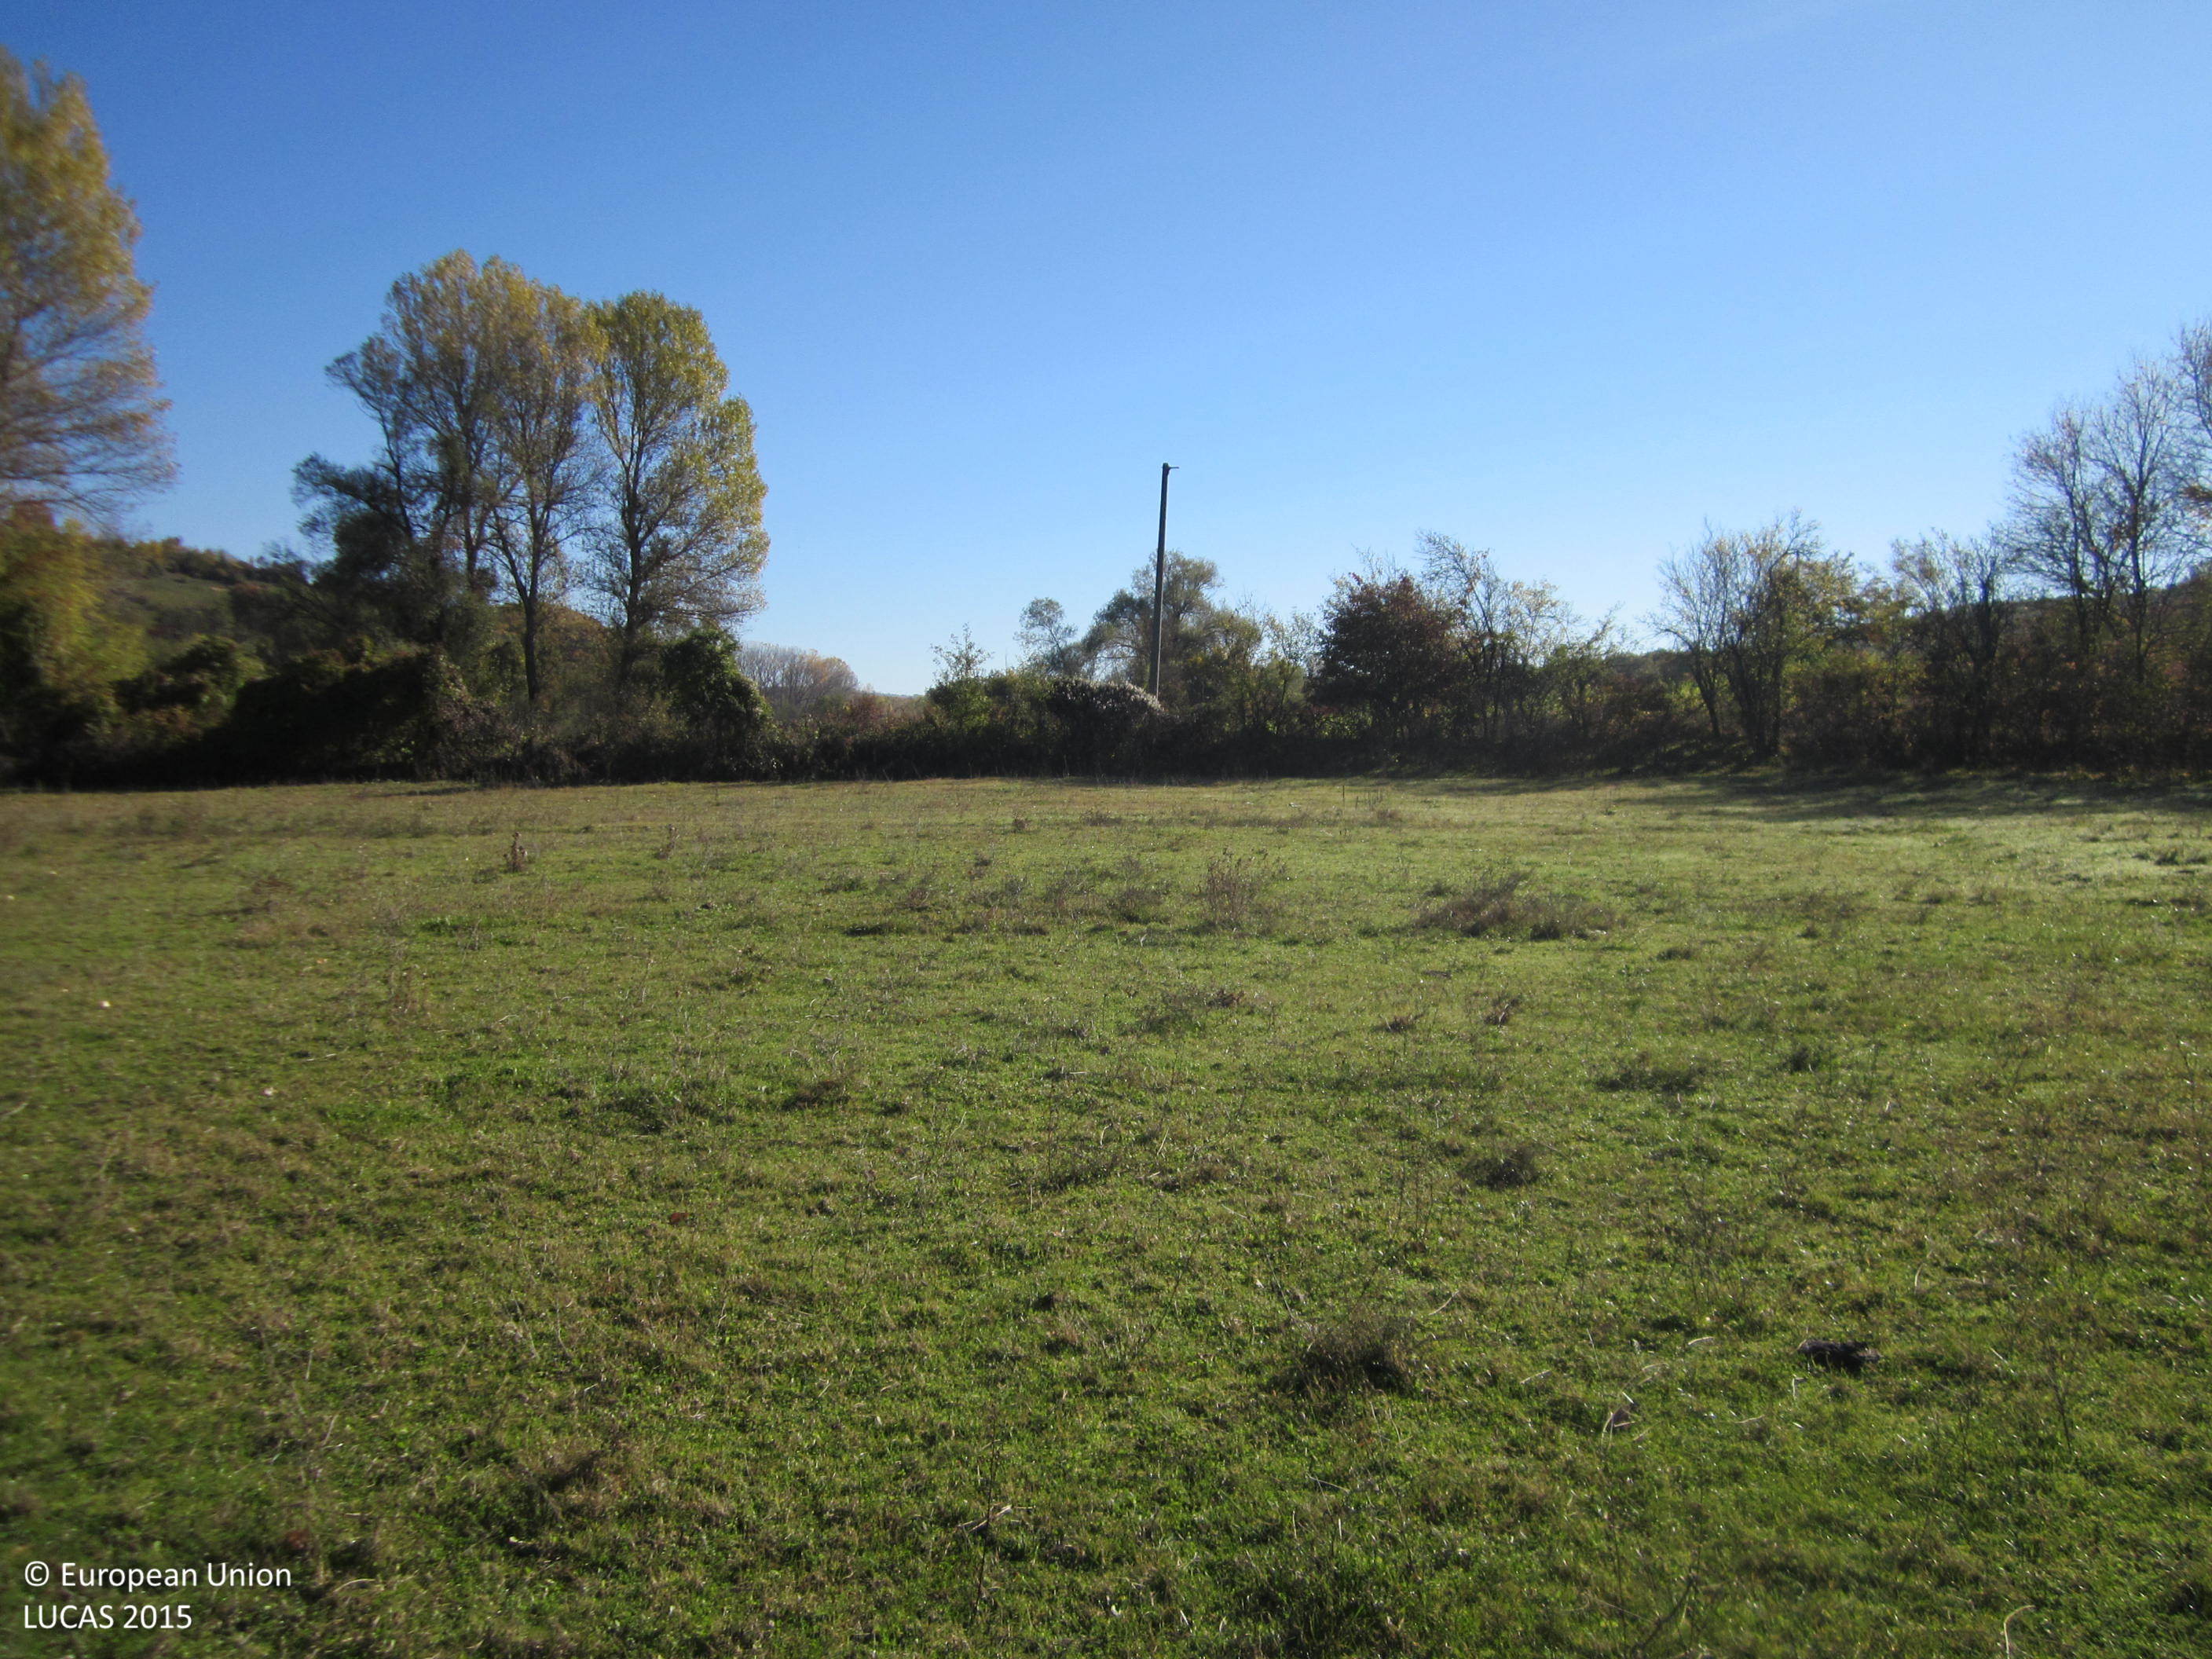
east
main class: Grassland
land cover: Grassland without tree/shrub cover
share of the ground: > 75 %
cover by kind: herbaceous plants 100 %
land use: Agriculture (excluding fallow land and kitchen gardens)
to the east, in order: Grassland without tree/shrub cover; Fences; Abandoned hedges; Tobacco; Electric lines; Tobacco; Grassland without tree/shrub cover; Shrubland with sparse tree cover; Sand; Inland fresh water bodies; Sand
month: November
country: BG
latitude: 41.4424
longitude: 25.6797
